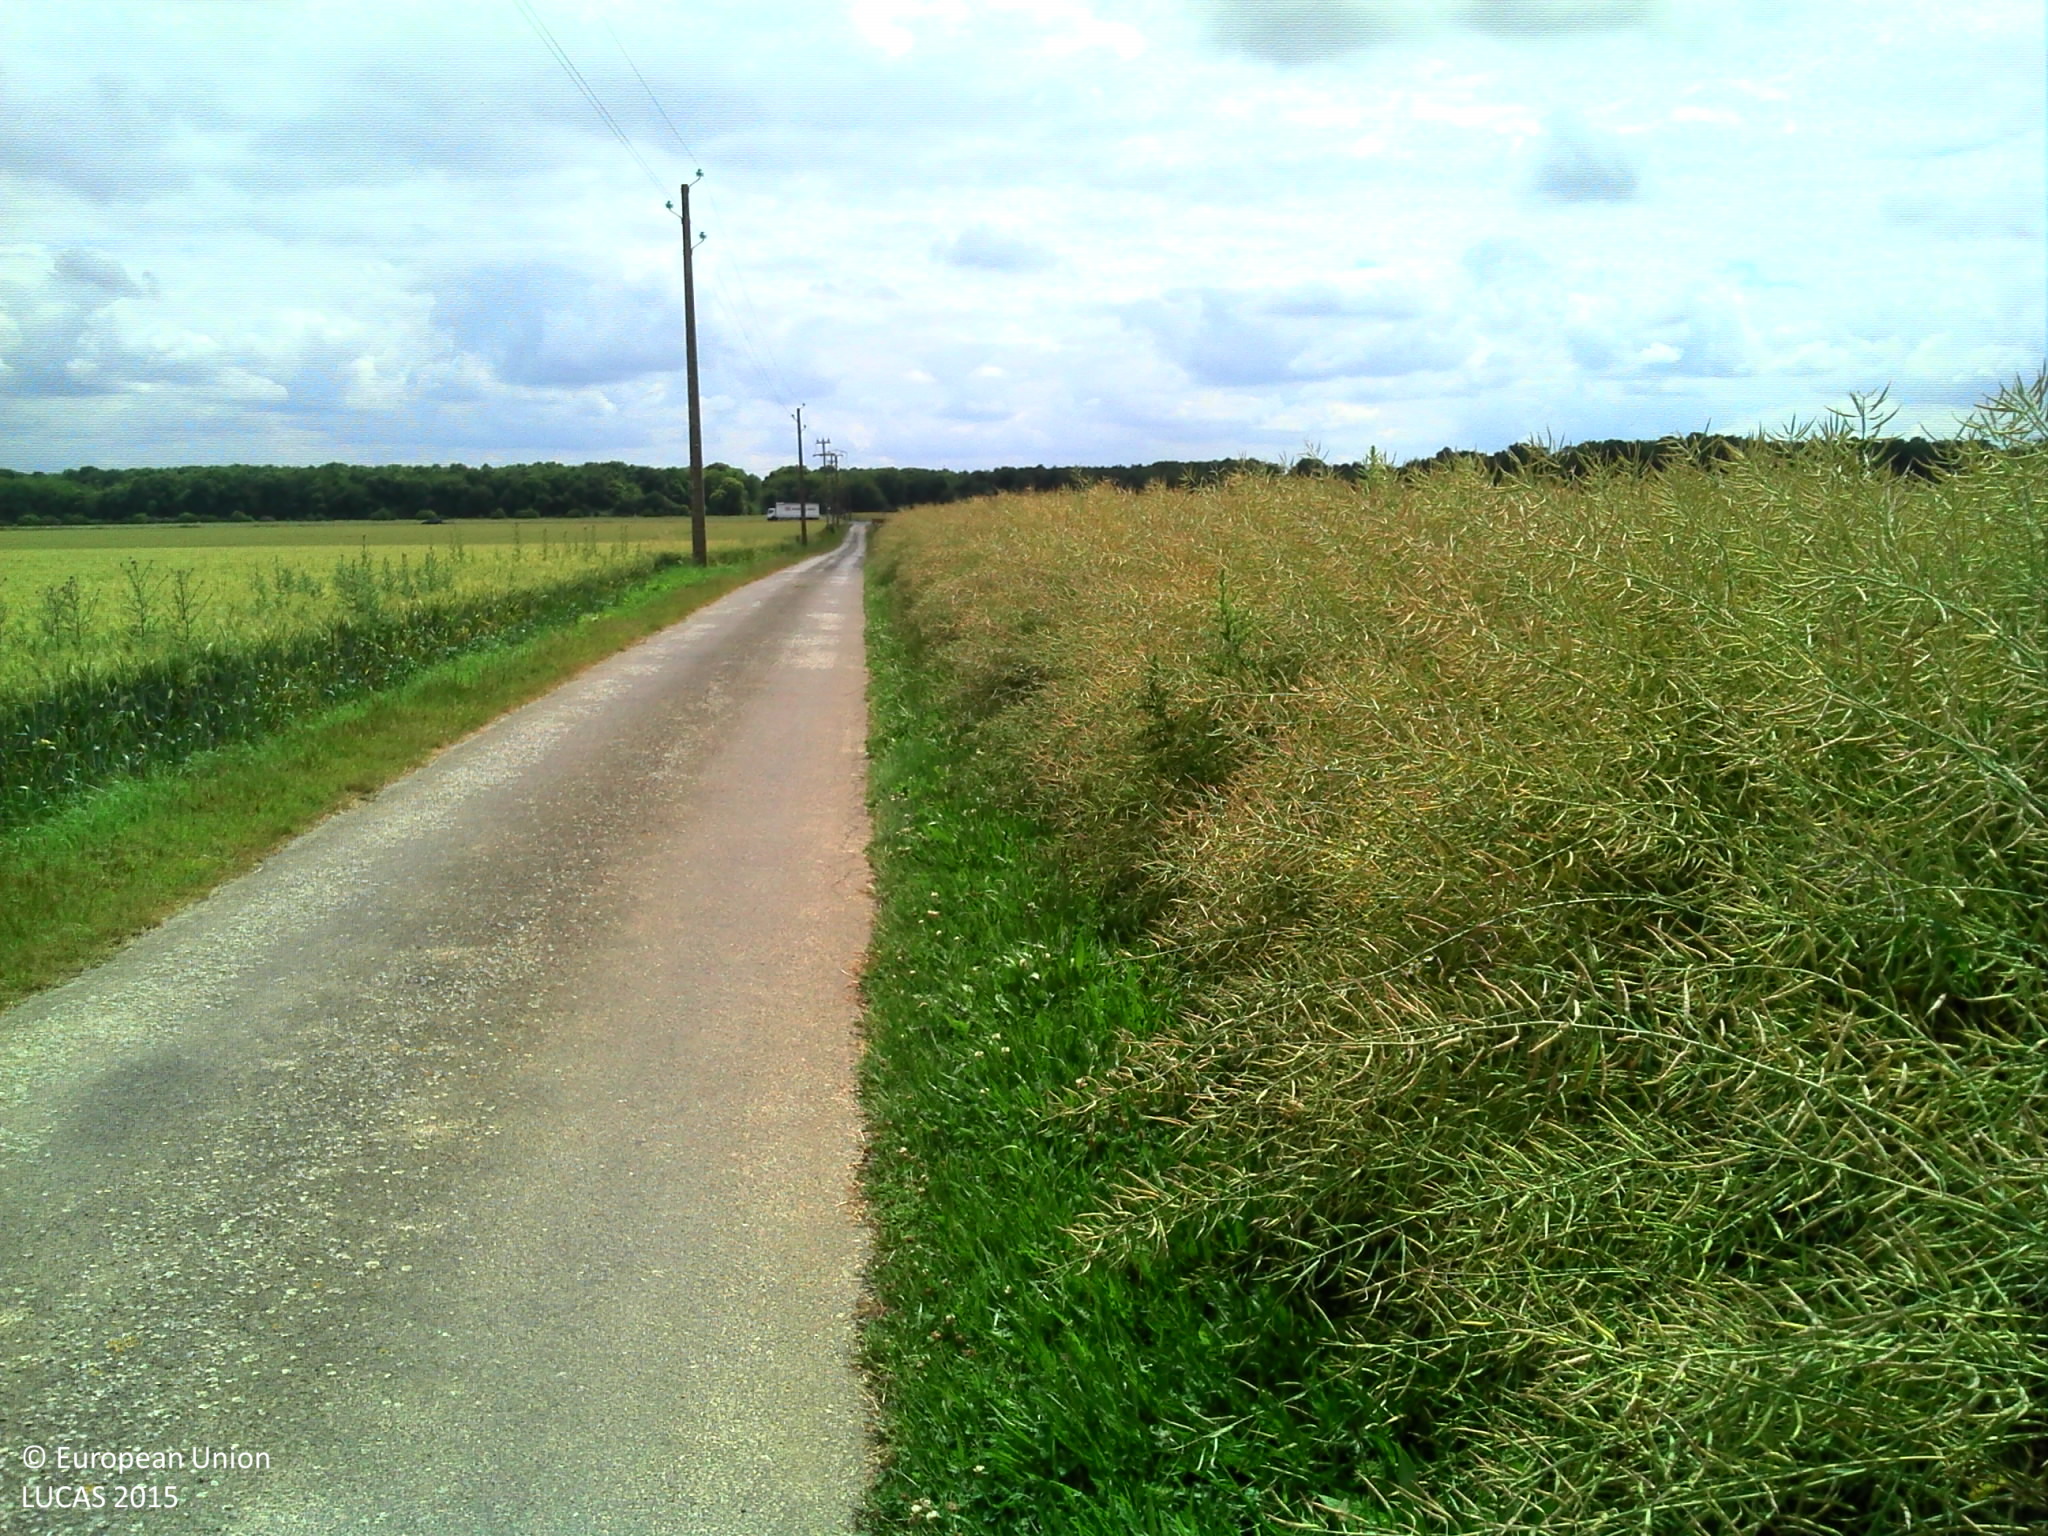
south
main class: Cropland
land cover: Rape and turnip rape
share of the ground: > 75 %
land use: Agriculture (excluding fallow land and kitchen gardens)
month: June
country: FR
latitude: 49.0168
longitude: 1.2705
